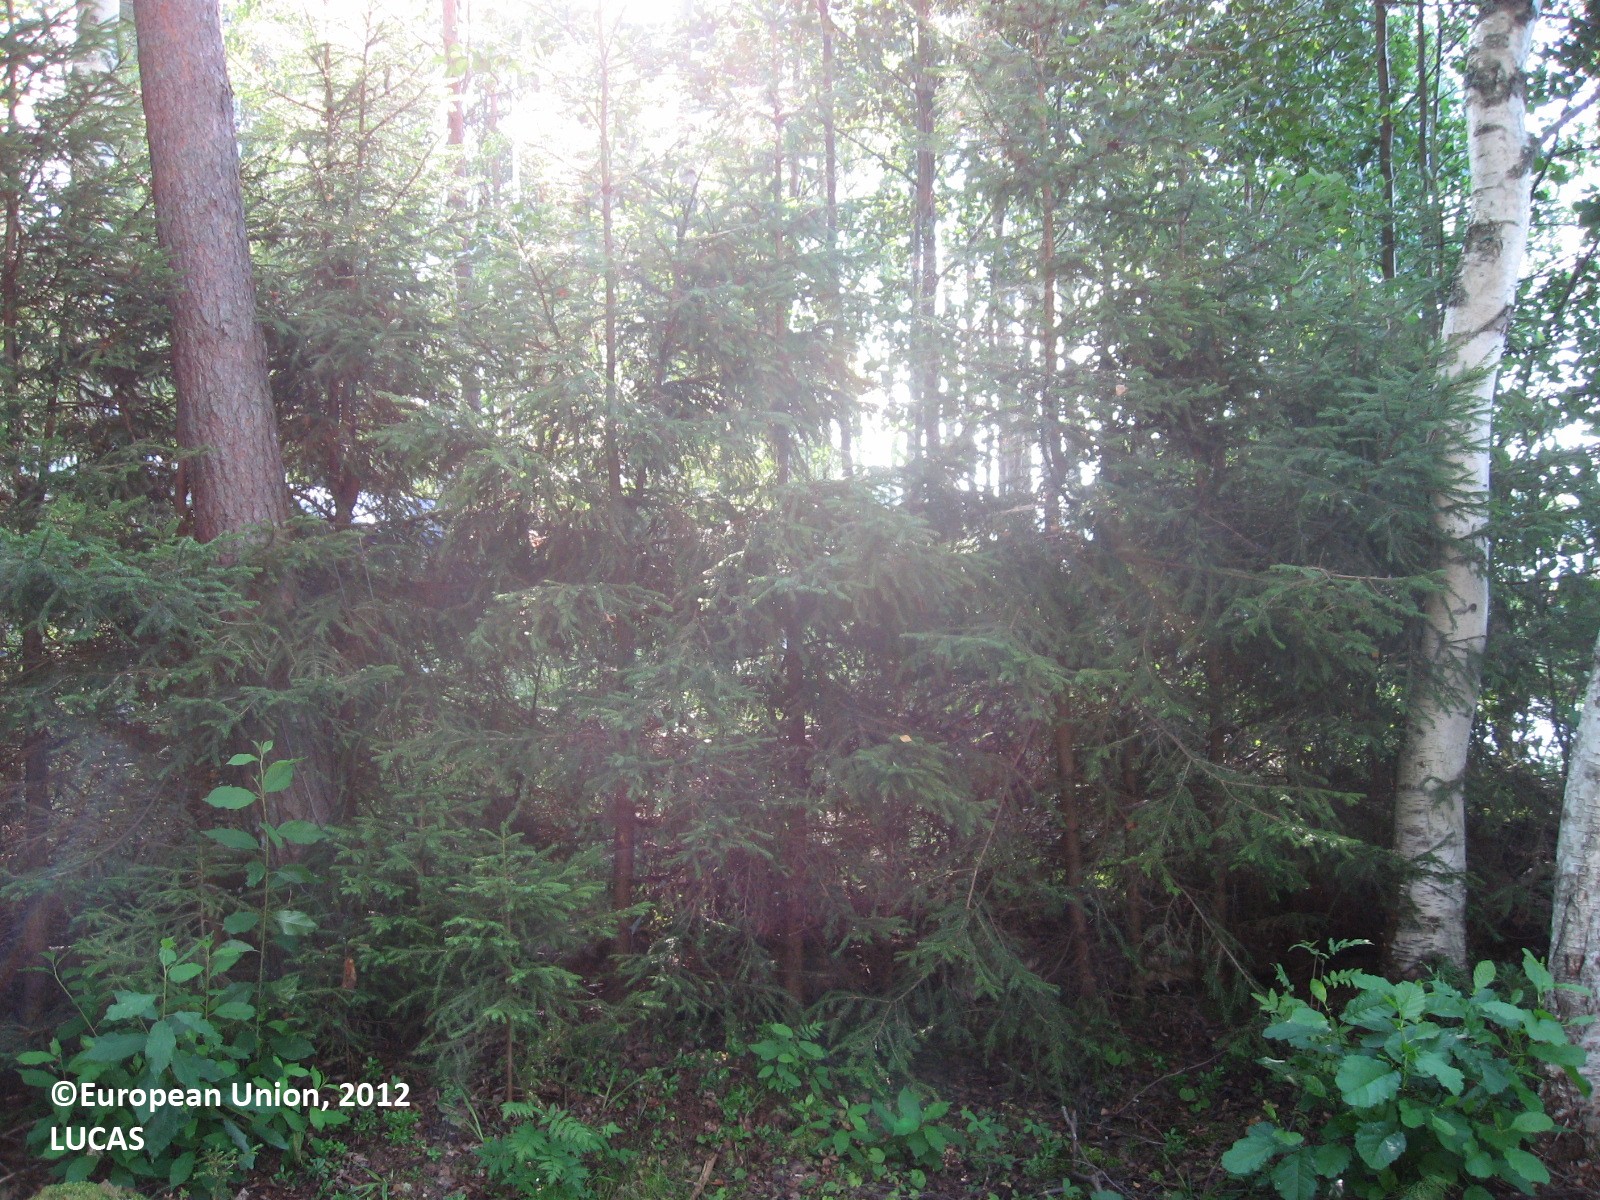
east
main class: Woodland
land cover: Other mixed woodland
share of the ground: 50 - 75 %
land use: Forestry
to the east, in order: Other mixed woodland; Managed hedges; Broadleaved woodland; Rivers and streams; Other mixed woodland; Artificial constructions in urban areas; Inland water bodies; Artificial constructions in urban areas; Inland water bodies; Spruce dominated mixed woodland; Artificial constructions in urban areas; Grassland with sparse tree/shrub cover; Artificial constructions in urban areas; Spruce dominated mixed woodland
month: August
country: FI
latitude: 61.4368
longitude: 25.9764
